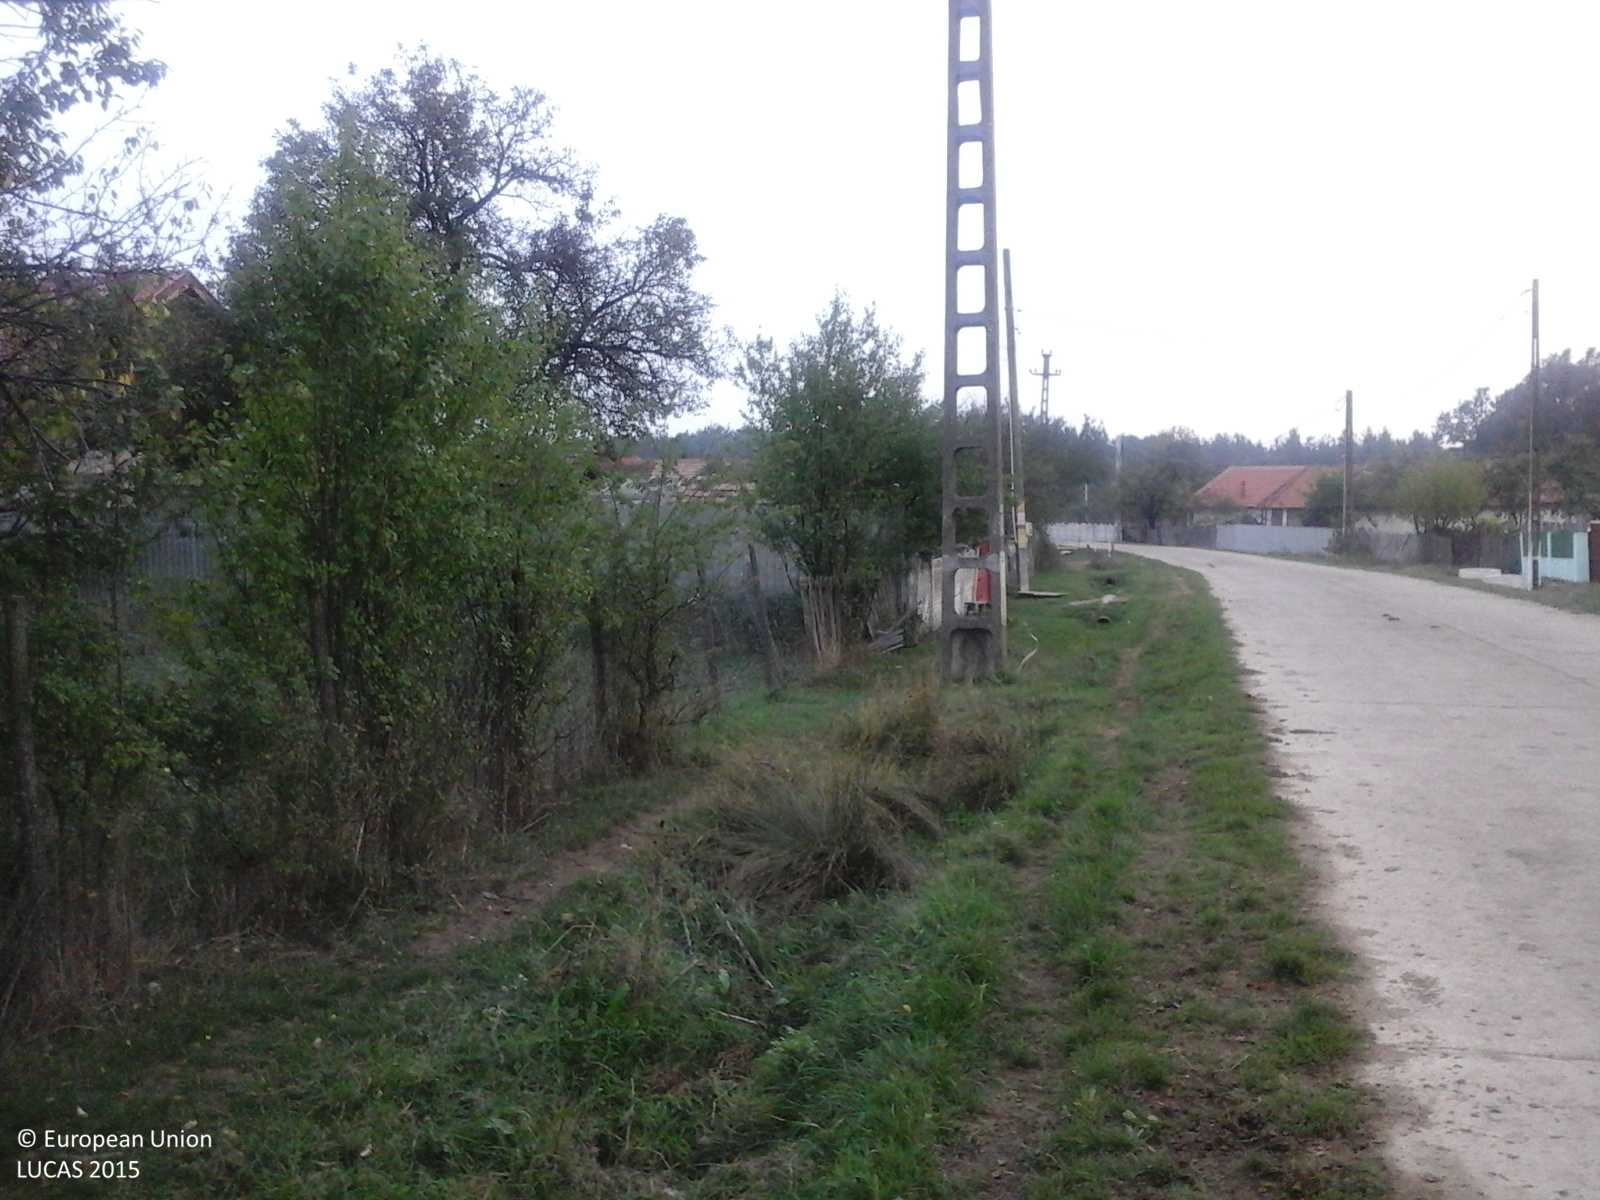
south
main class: Cropland
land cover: Vineyards
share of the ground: > 75 %
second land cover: Grassland without tree/shrub cover
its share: > 75 %
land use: Agriculture (excluding fallow land and kitchen gardens)
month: September
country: RO
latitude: 44.9346
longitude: 23.4239
